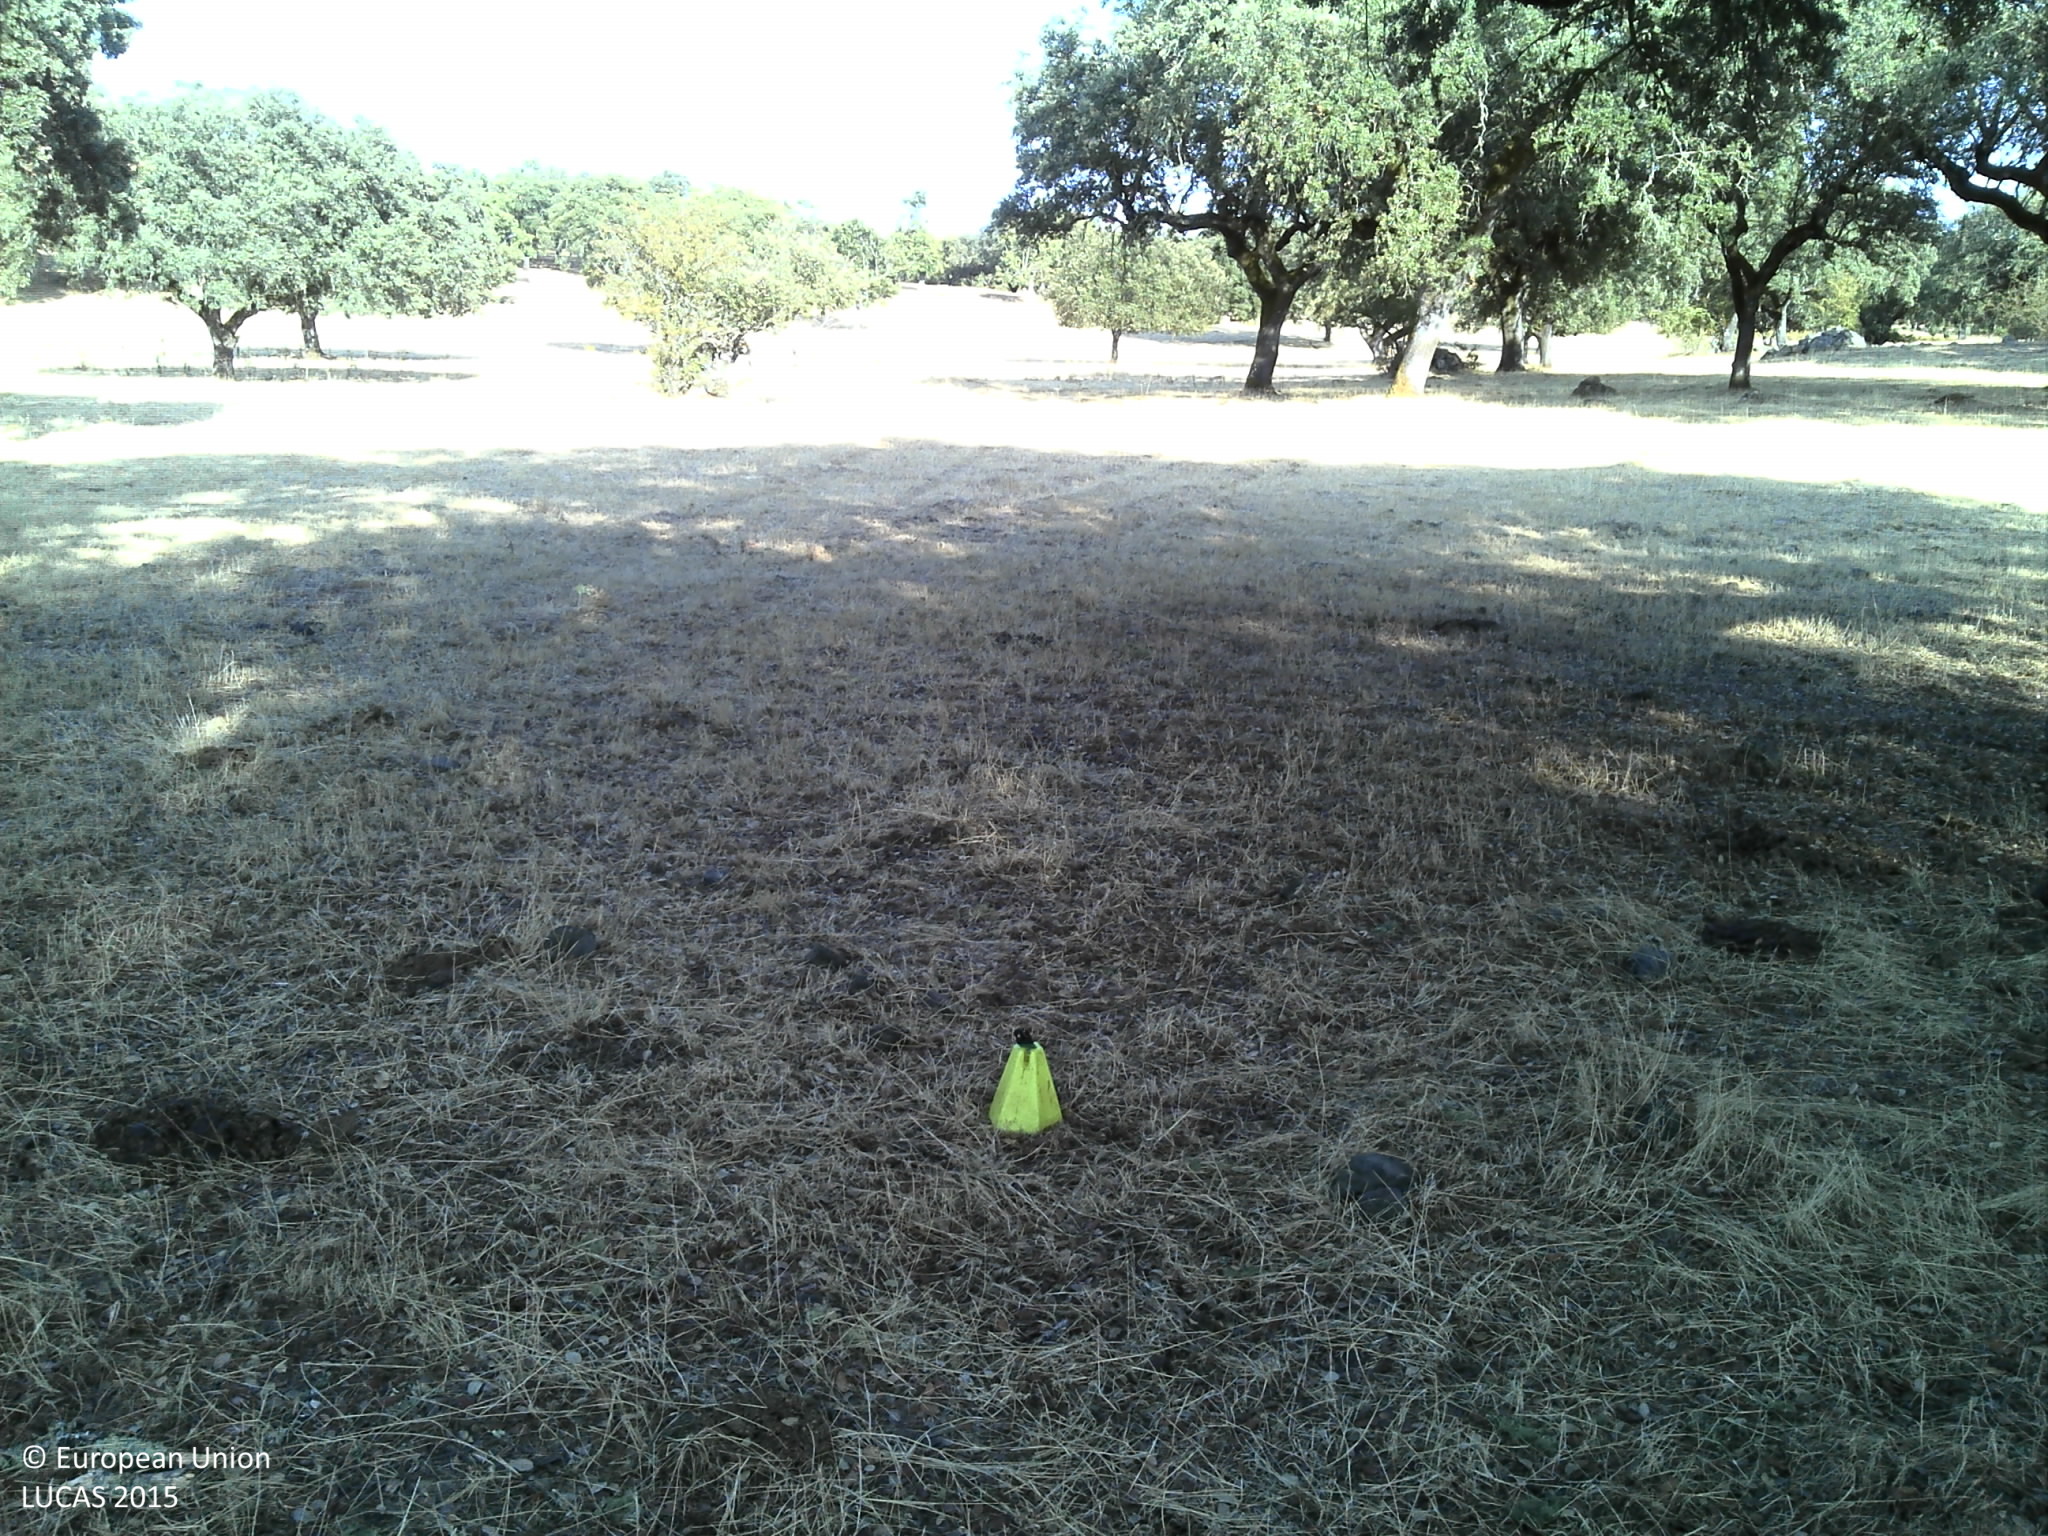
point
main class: Woodland
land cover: Broadleaved woodland
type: broadleaved evergreen forest
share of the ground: 25 - 50 %
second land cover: Grassland without tree/shrub cover
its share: 10 - 25 %
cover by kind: unconsolidated bare surface 55 %, broadleaved forest trees 30 %, herbaceous plants 15 %
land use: Forestry
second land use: Agriculture (excluding fallow land and kitchen gardens)
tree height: > 5 m
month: August
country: PT
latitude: 39.3181
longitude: -7.5473
